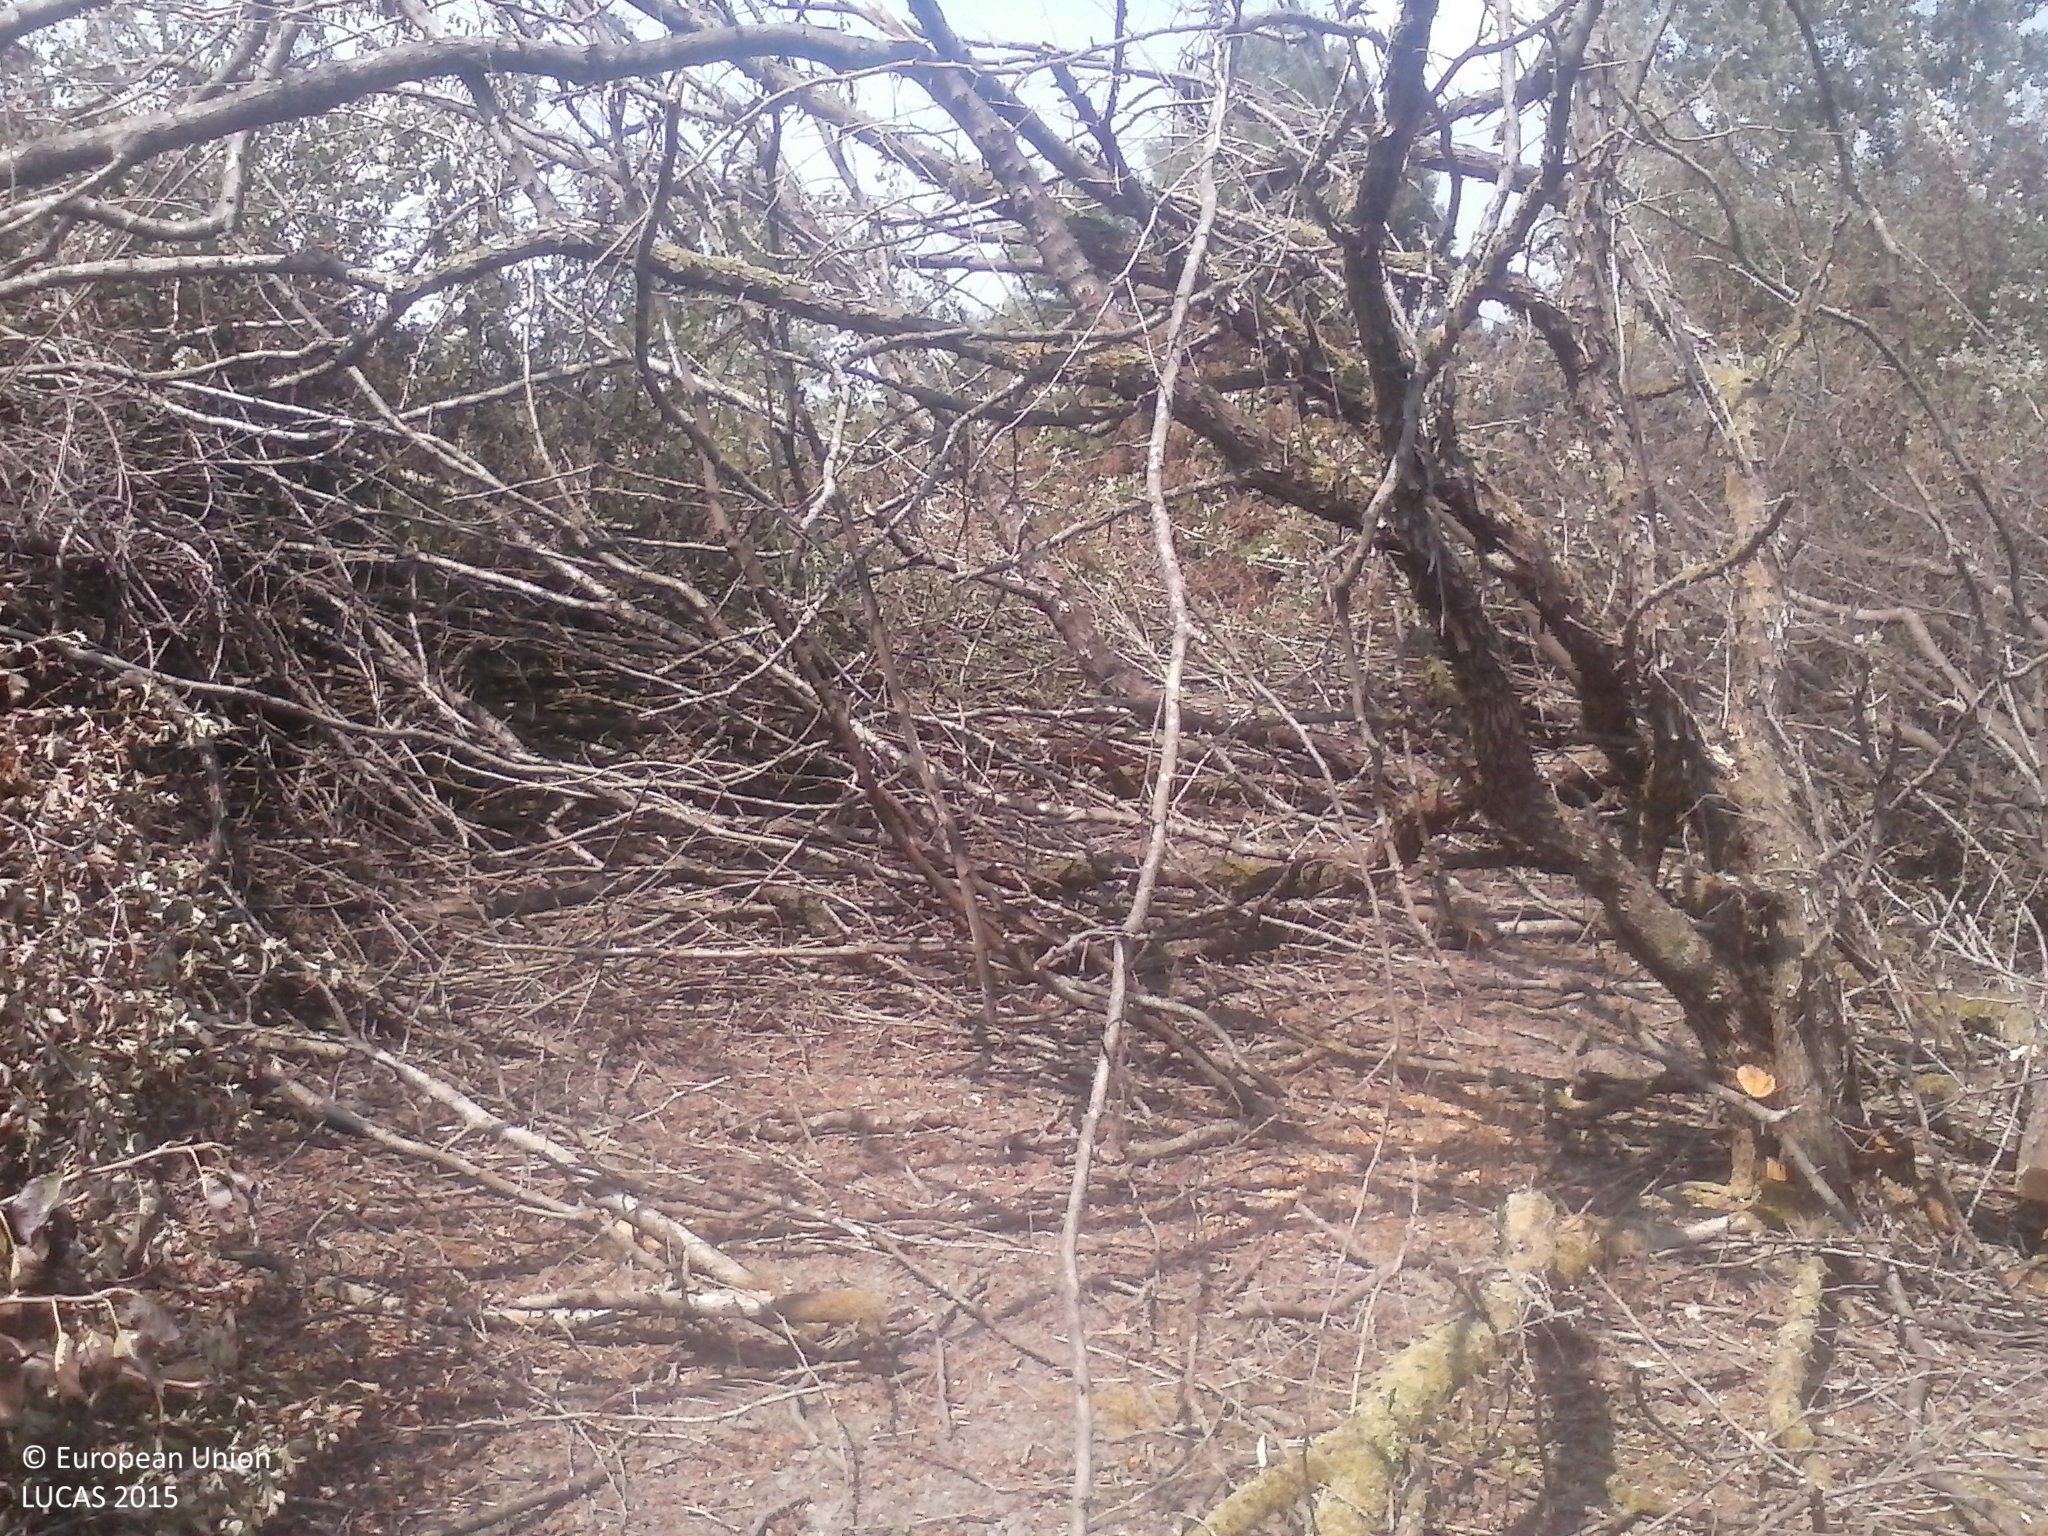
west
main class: Woodland
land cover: Broadleaved woodland
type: mesophytic deciduous forest
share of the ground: > 75 %
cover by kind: broadleaved forest trees 90 %, shrubs 5 %, herbaceous plants 5 %
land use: Forestry
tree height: < 5 m
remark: Clear cut
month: August
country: HU
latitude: 45.9210
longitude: 17.8053
